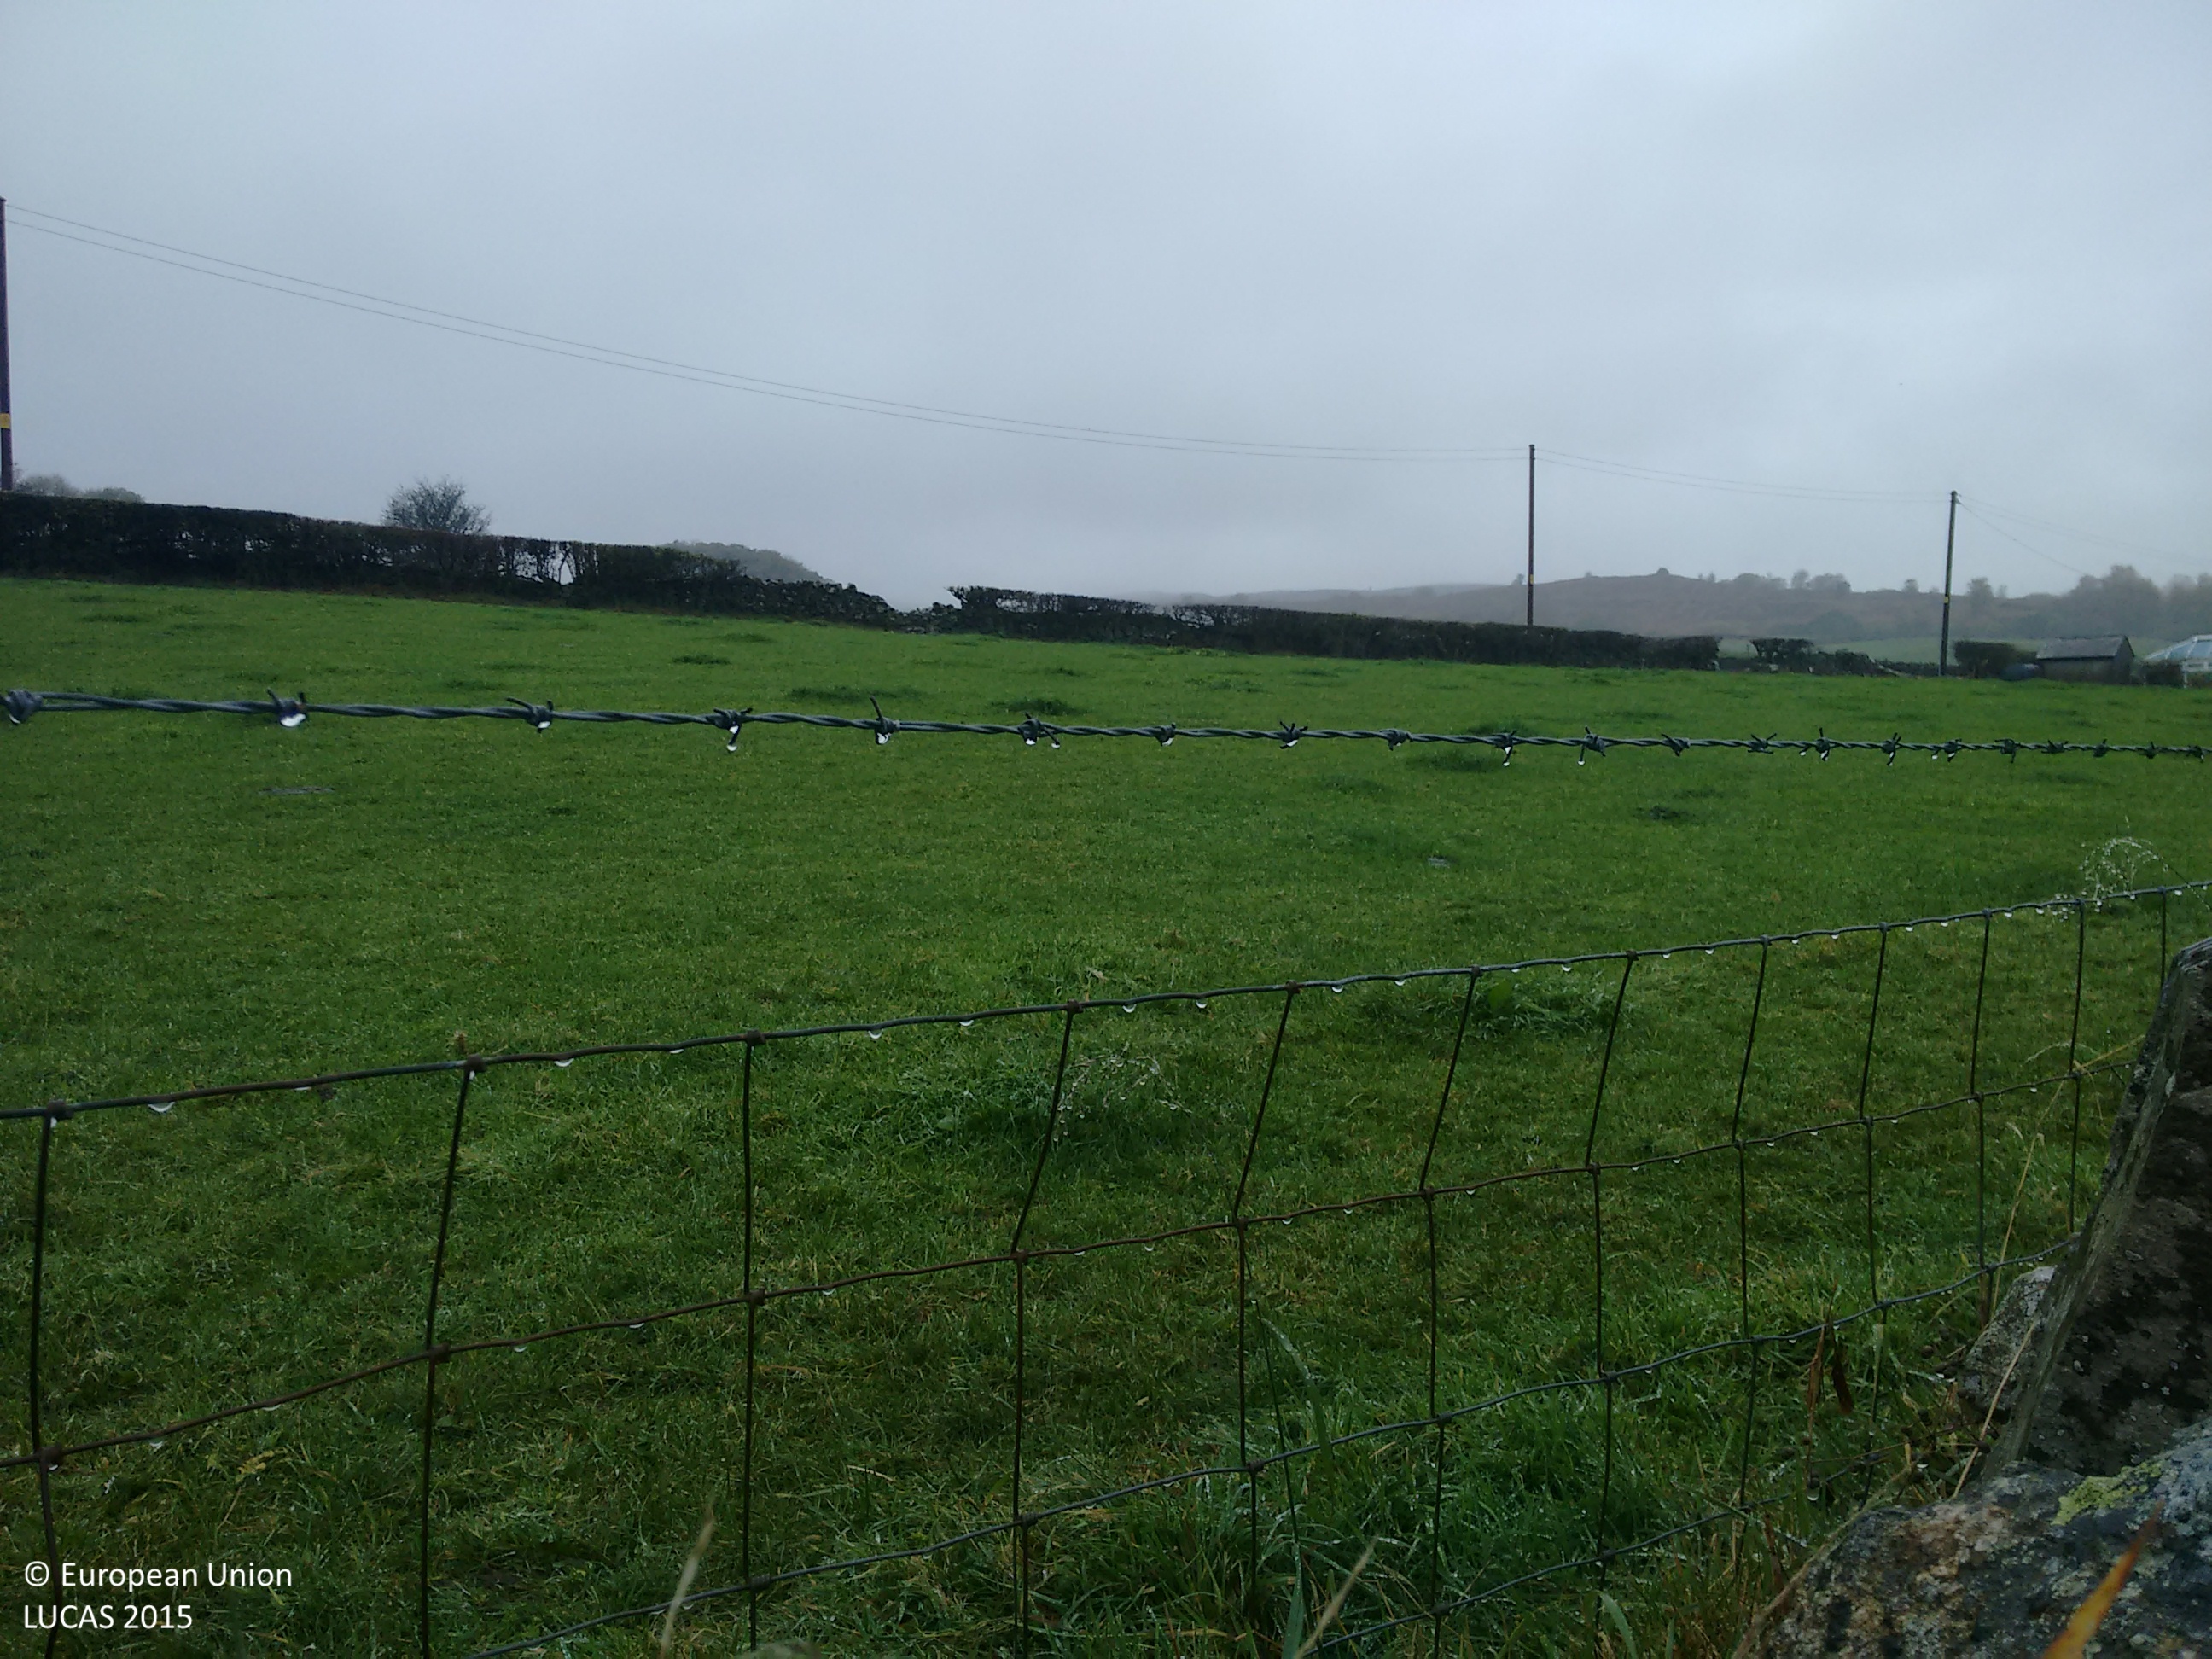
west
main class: Grassland
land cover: Grassland without tree/shrub cover
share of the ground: > 75 %
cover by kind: herbaceous plants 100 %
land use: Agriculture (excluding fallow land and kitchen gardens)
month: October
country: GB
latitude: 54.2566
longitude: -3.0760
